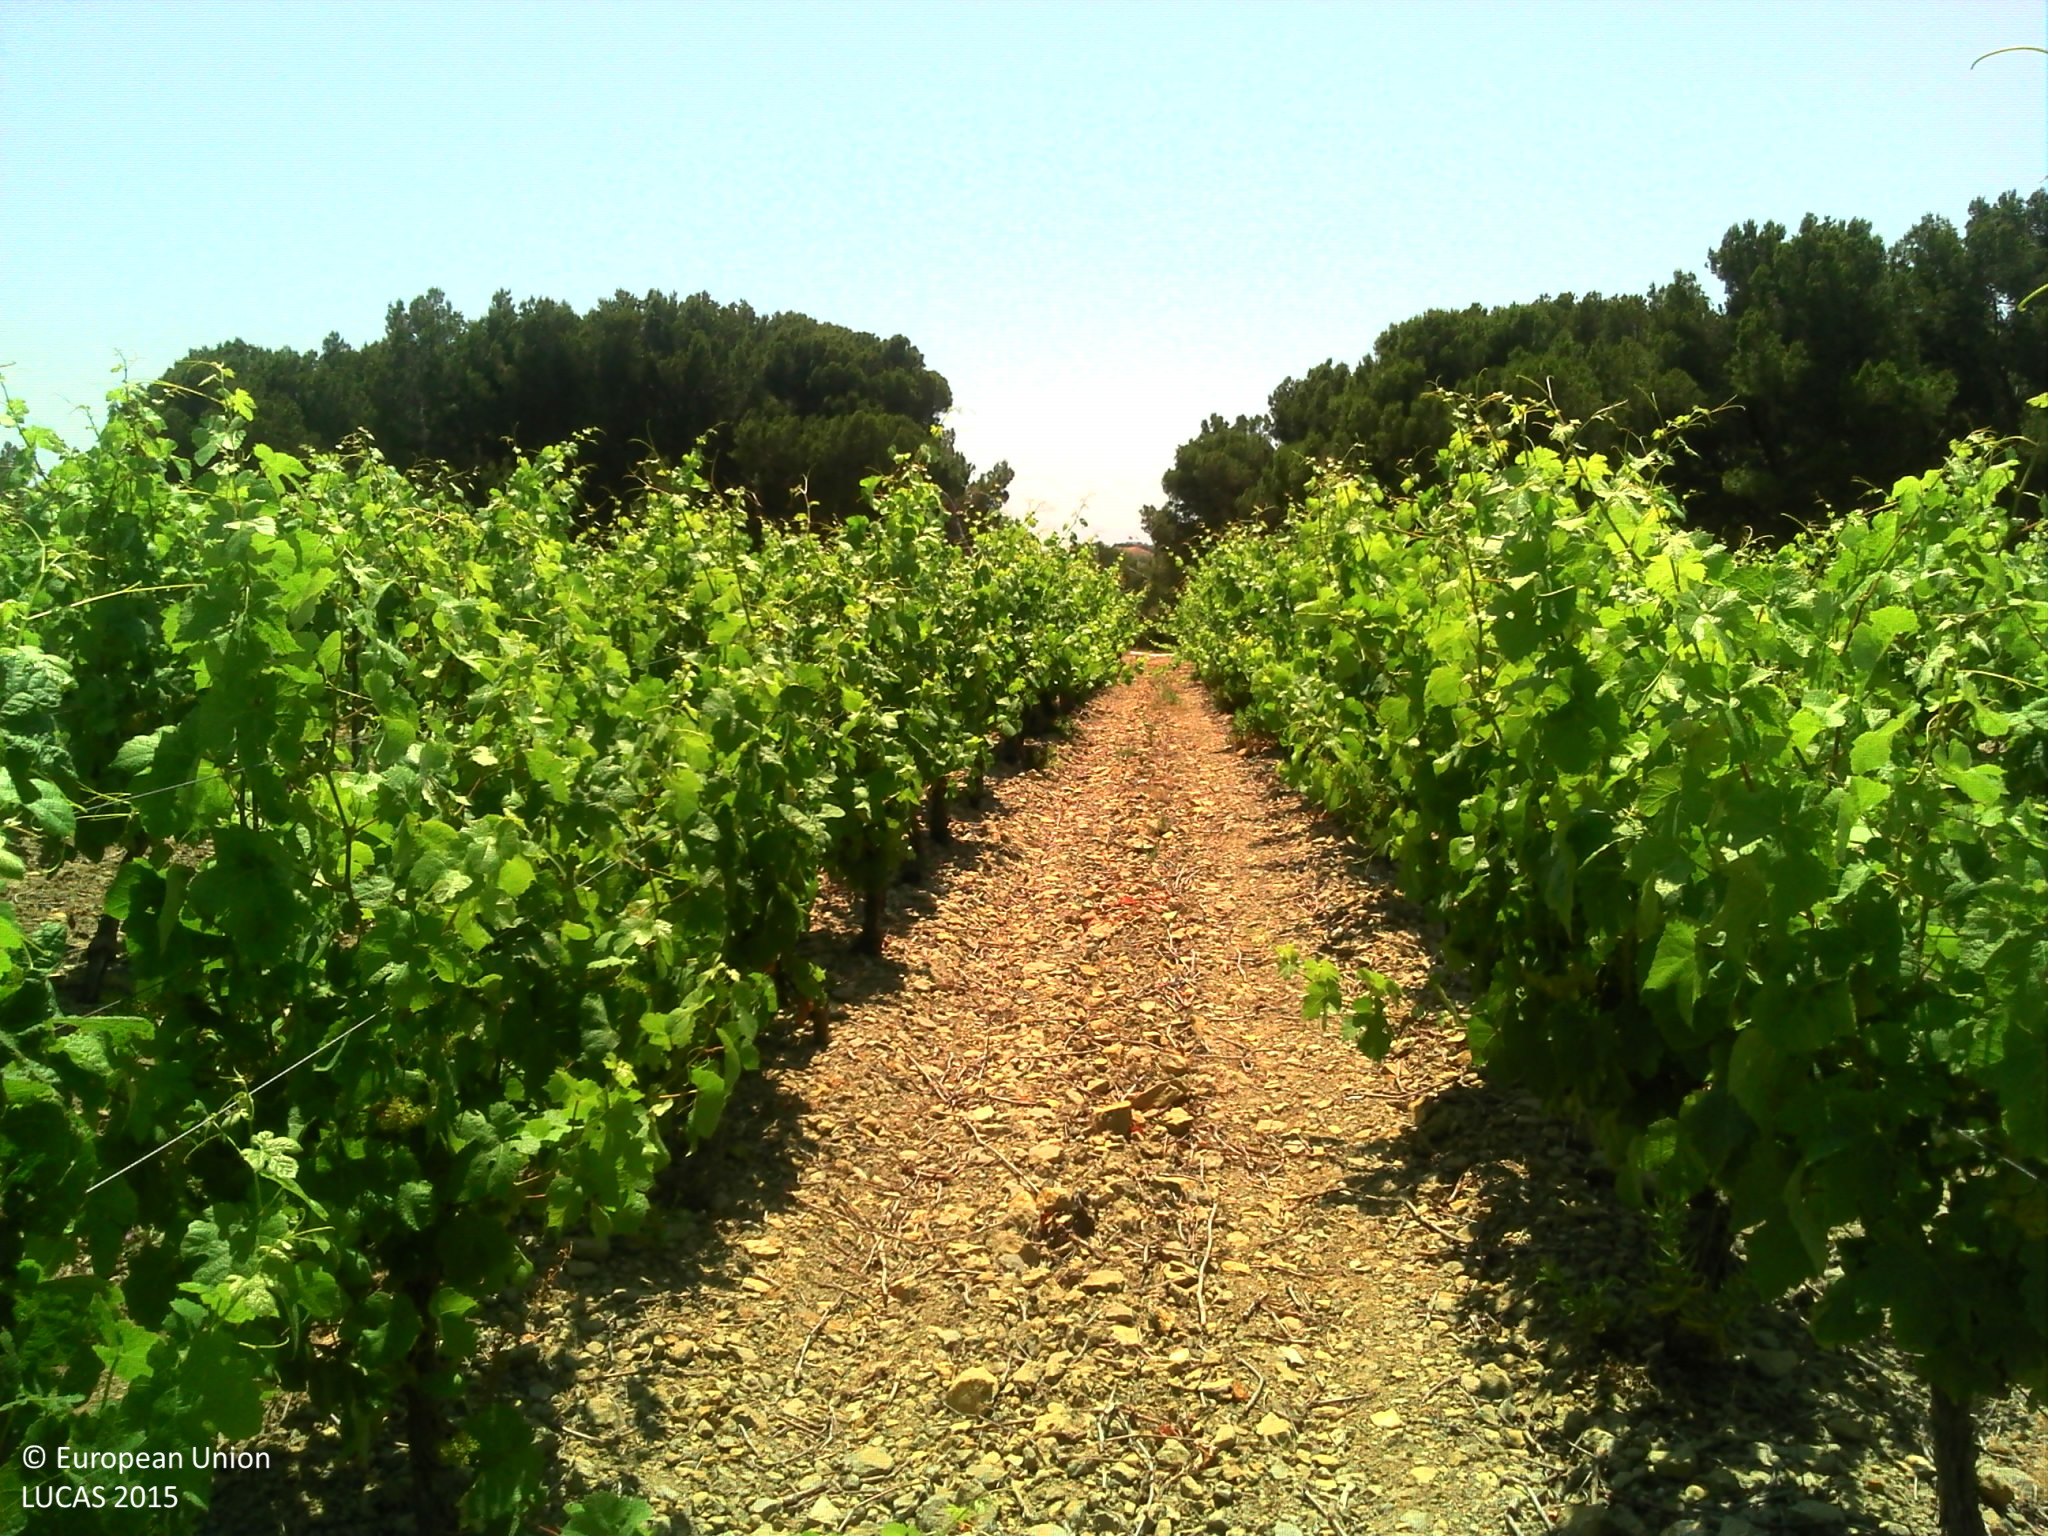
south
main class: Cropland
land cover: Vineyards
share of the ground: 50 - 75 %
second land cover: Other bare soil
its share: > 75 %
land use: Agriculture (excluding fallow land and kitchen gardens)
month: June
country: FR
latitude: 43.1260
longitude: 3.1145
